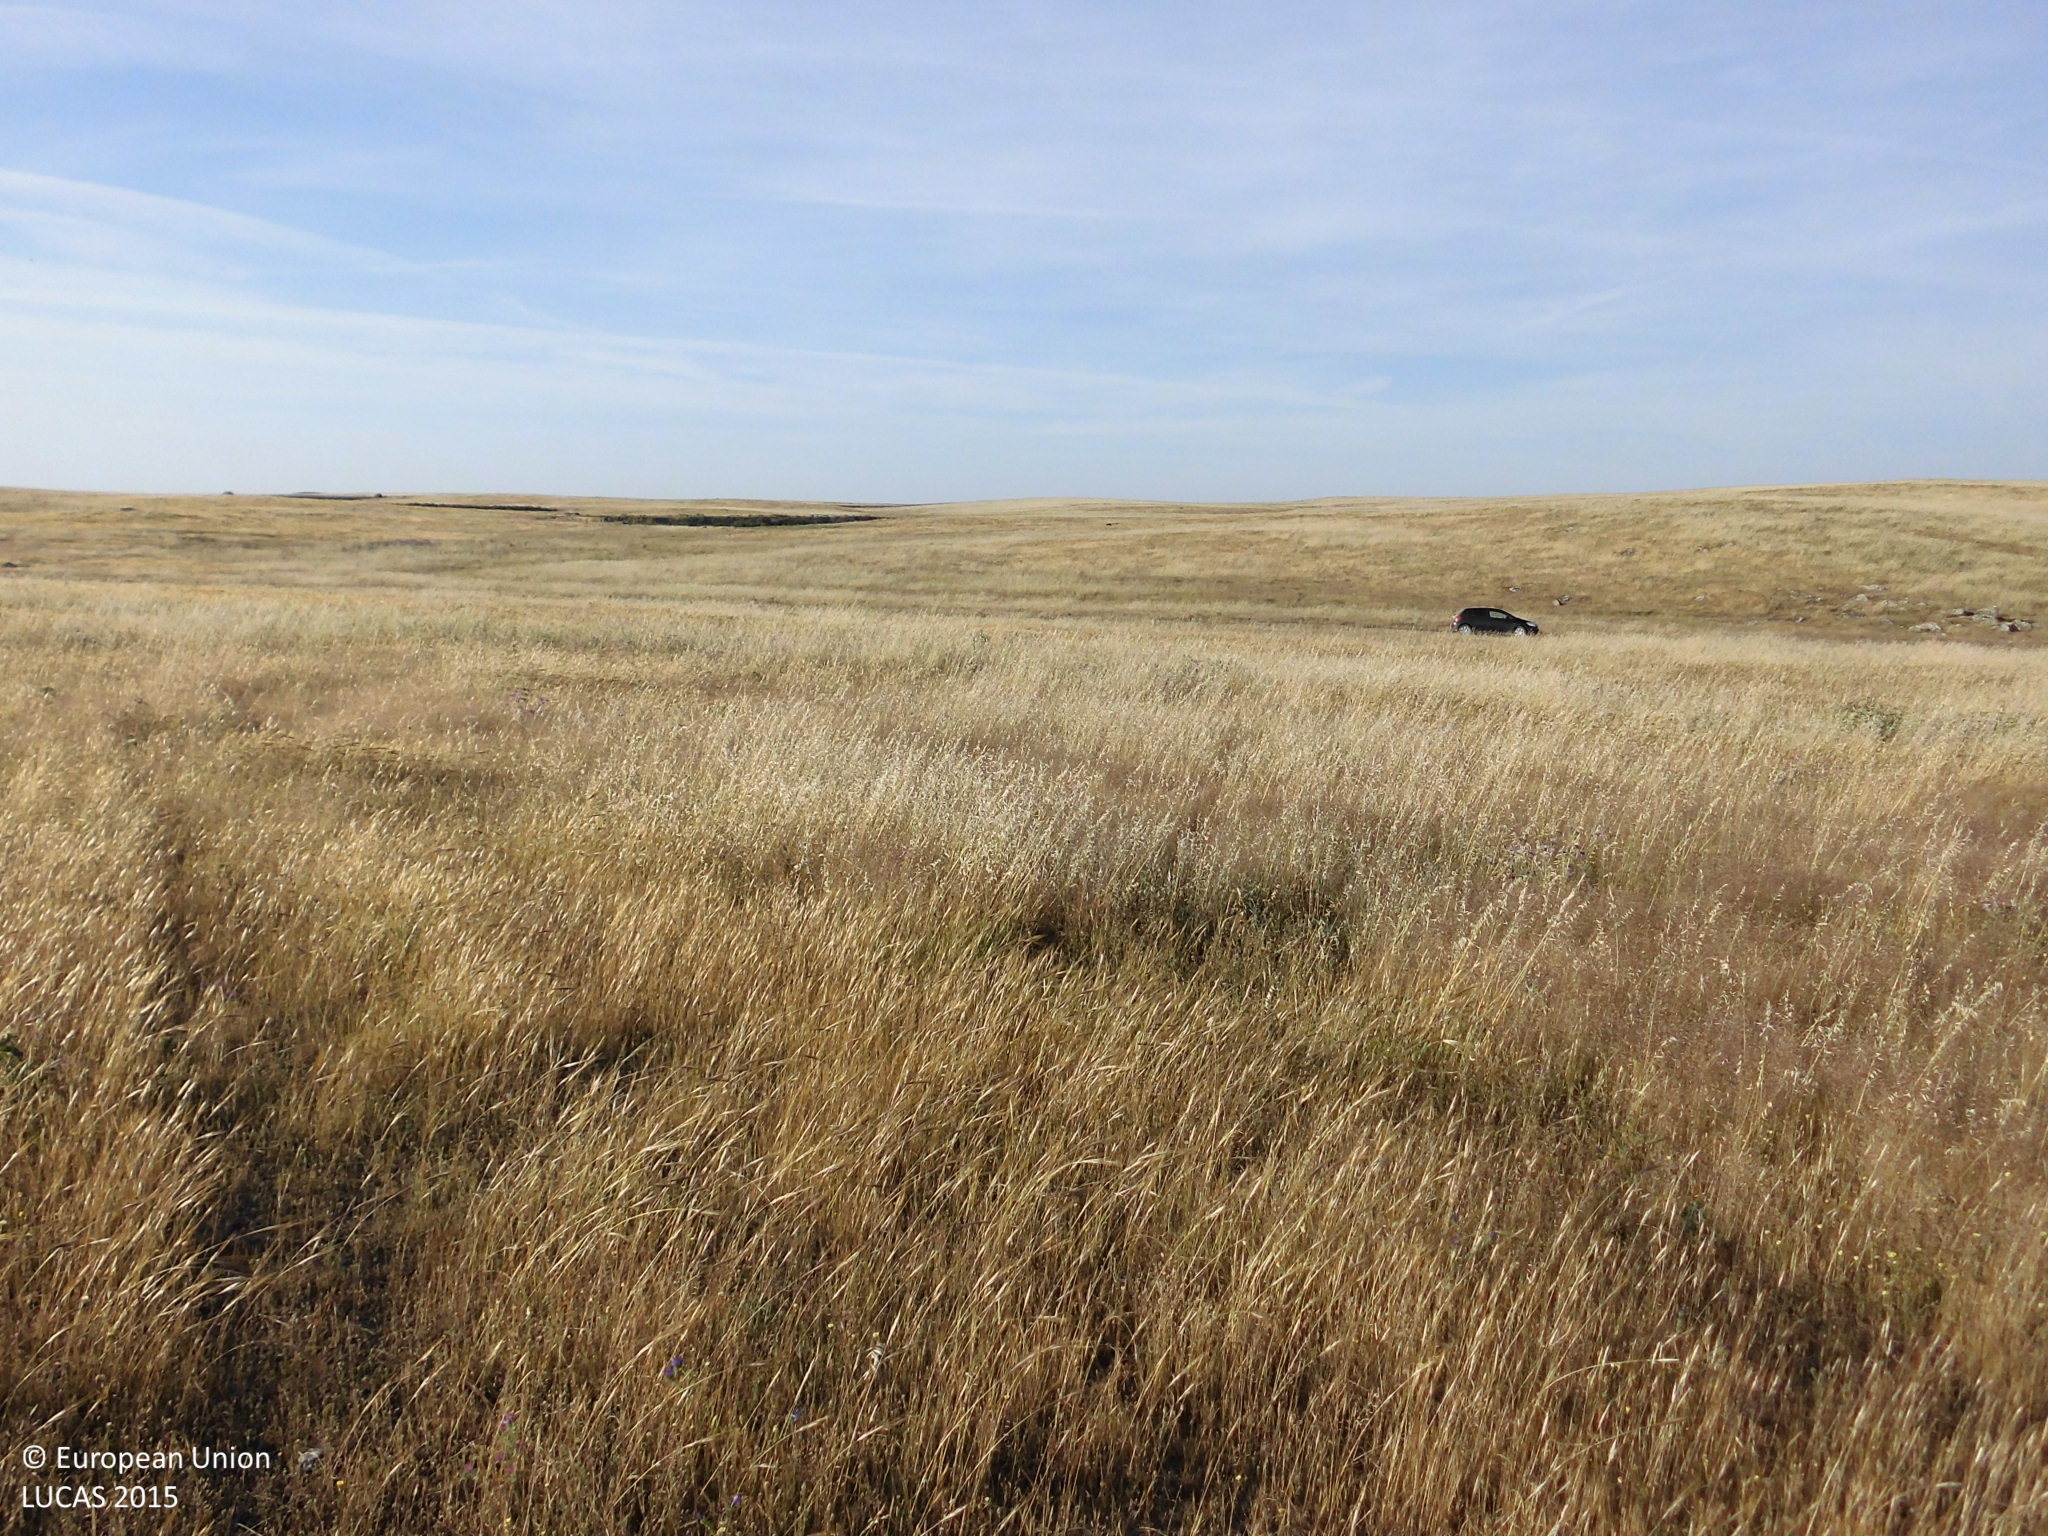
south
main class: Grassland
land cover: Grassland without tree/shrub cover
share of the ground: > 75 %
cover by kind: herbaceous plants 100 %
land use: Agriculture (excluding fallow land and kitchen gardens)
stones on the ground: 10 - 25 %
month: May
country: ES
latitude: 39.6301
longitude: -6.9413
